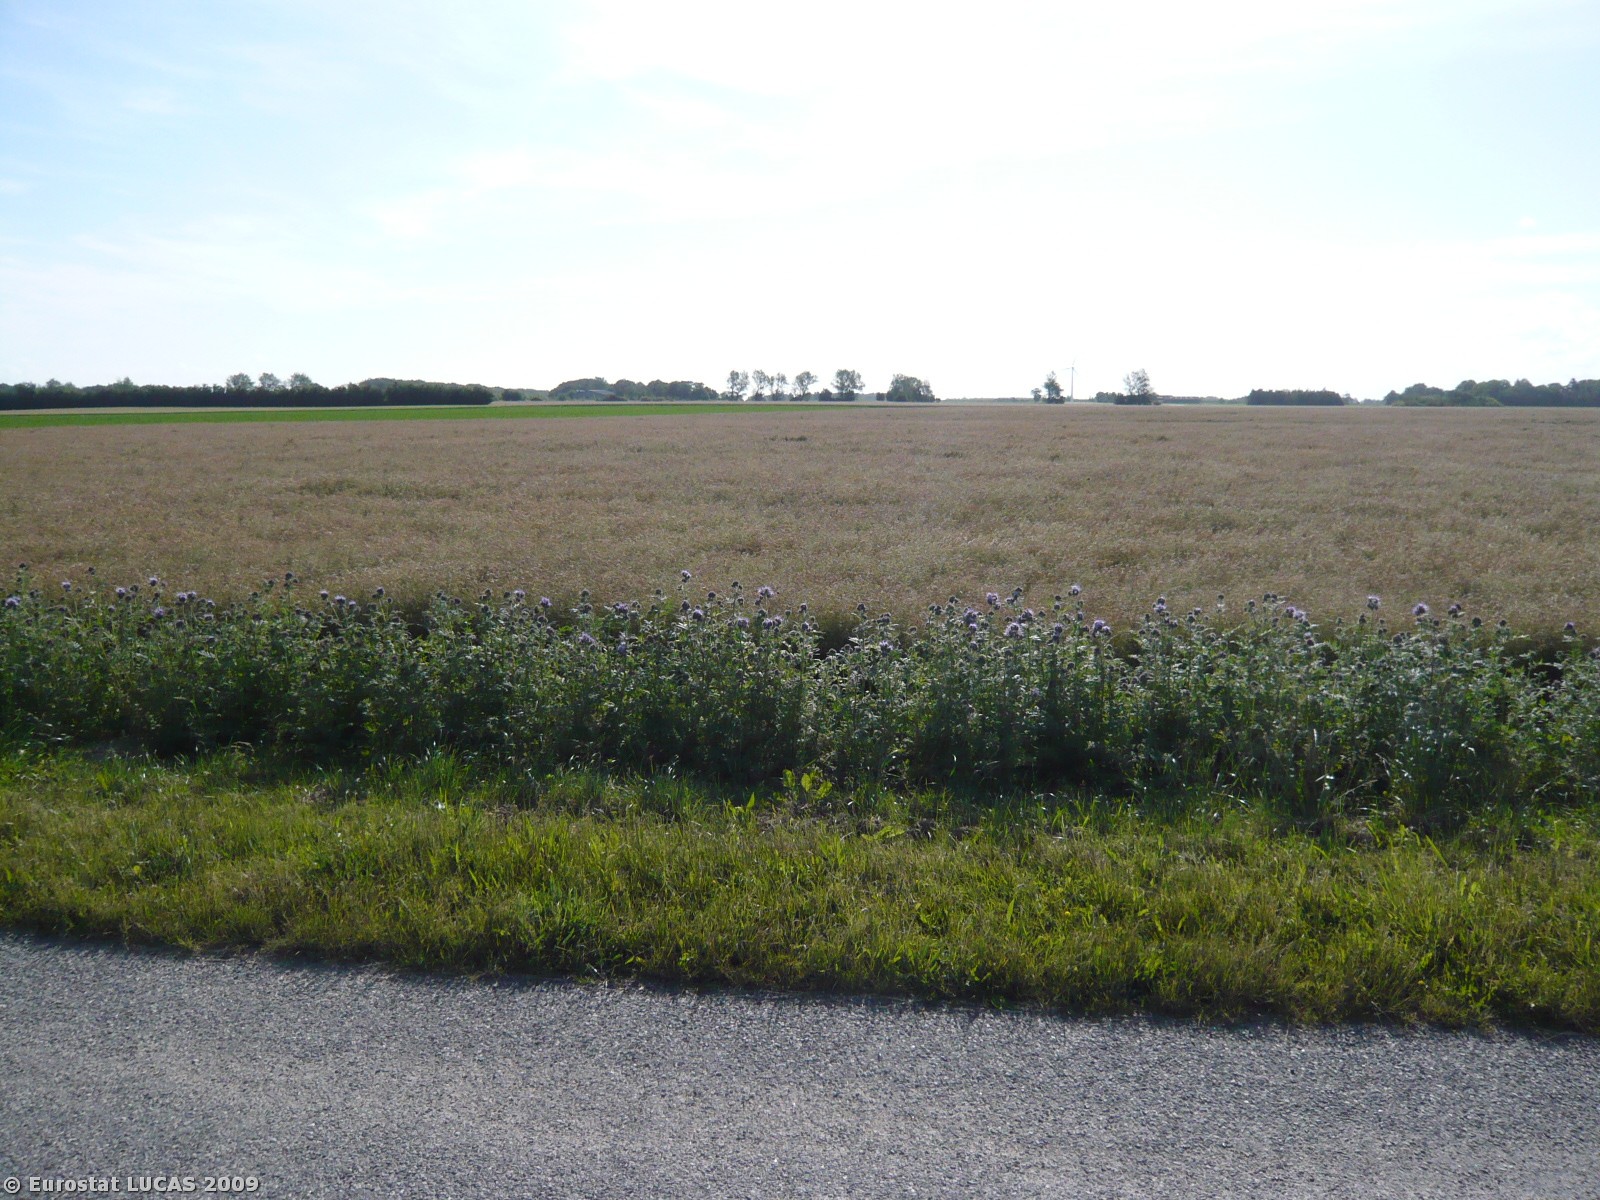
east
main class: Cropland
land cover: Common wheat
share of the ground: > 75 %
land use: Agriculture (excluding fallow land and kitchen gardens)
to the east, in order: Common wheat; Grass margins; Paved roads, cycling and walking lanes; Grass margins; Temporary grasslands
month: June
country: DK
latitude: 54.9249
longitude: 11.0759
